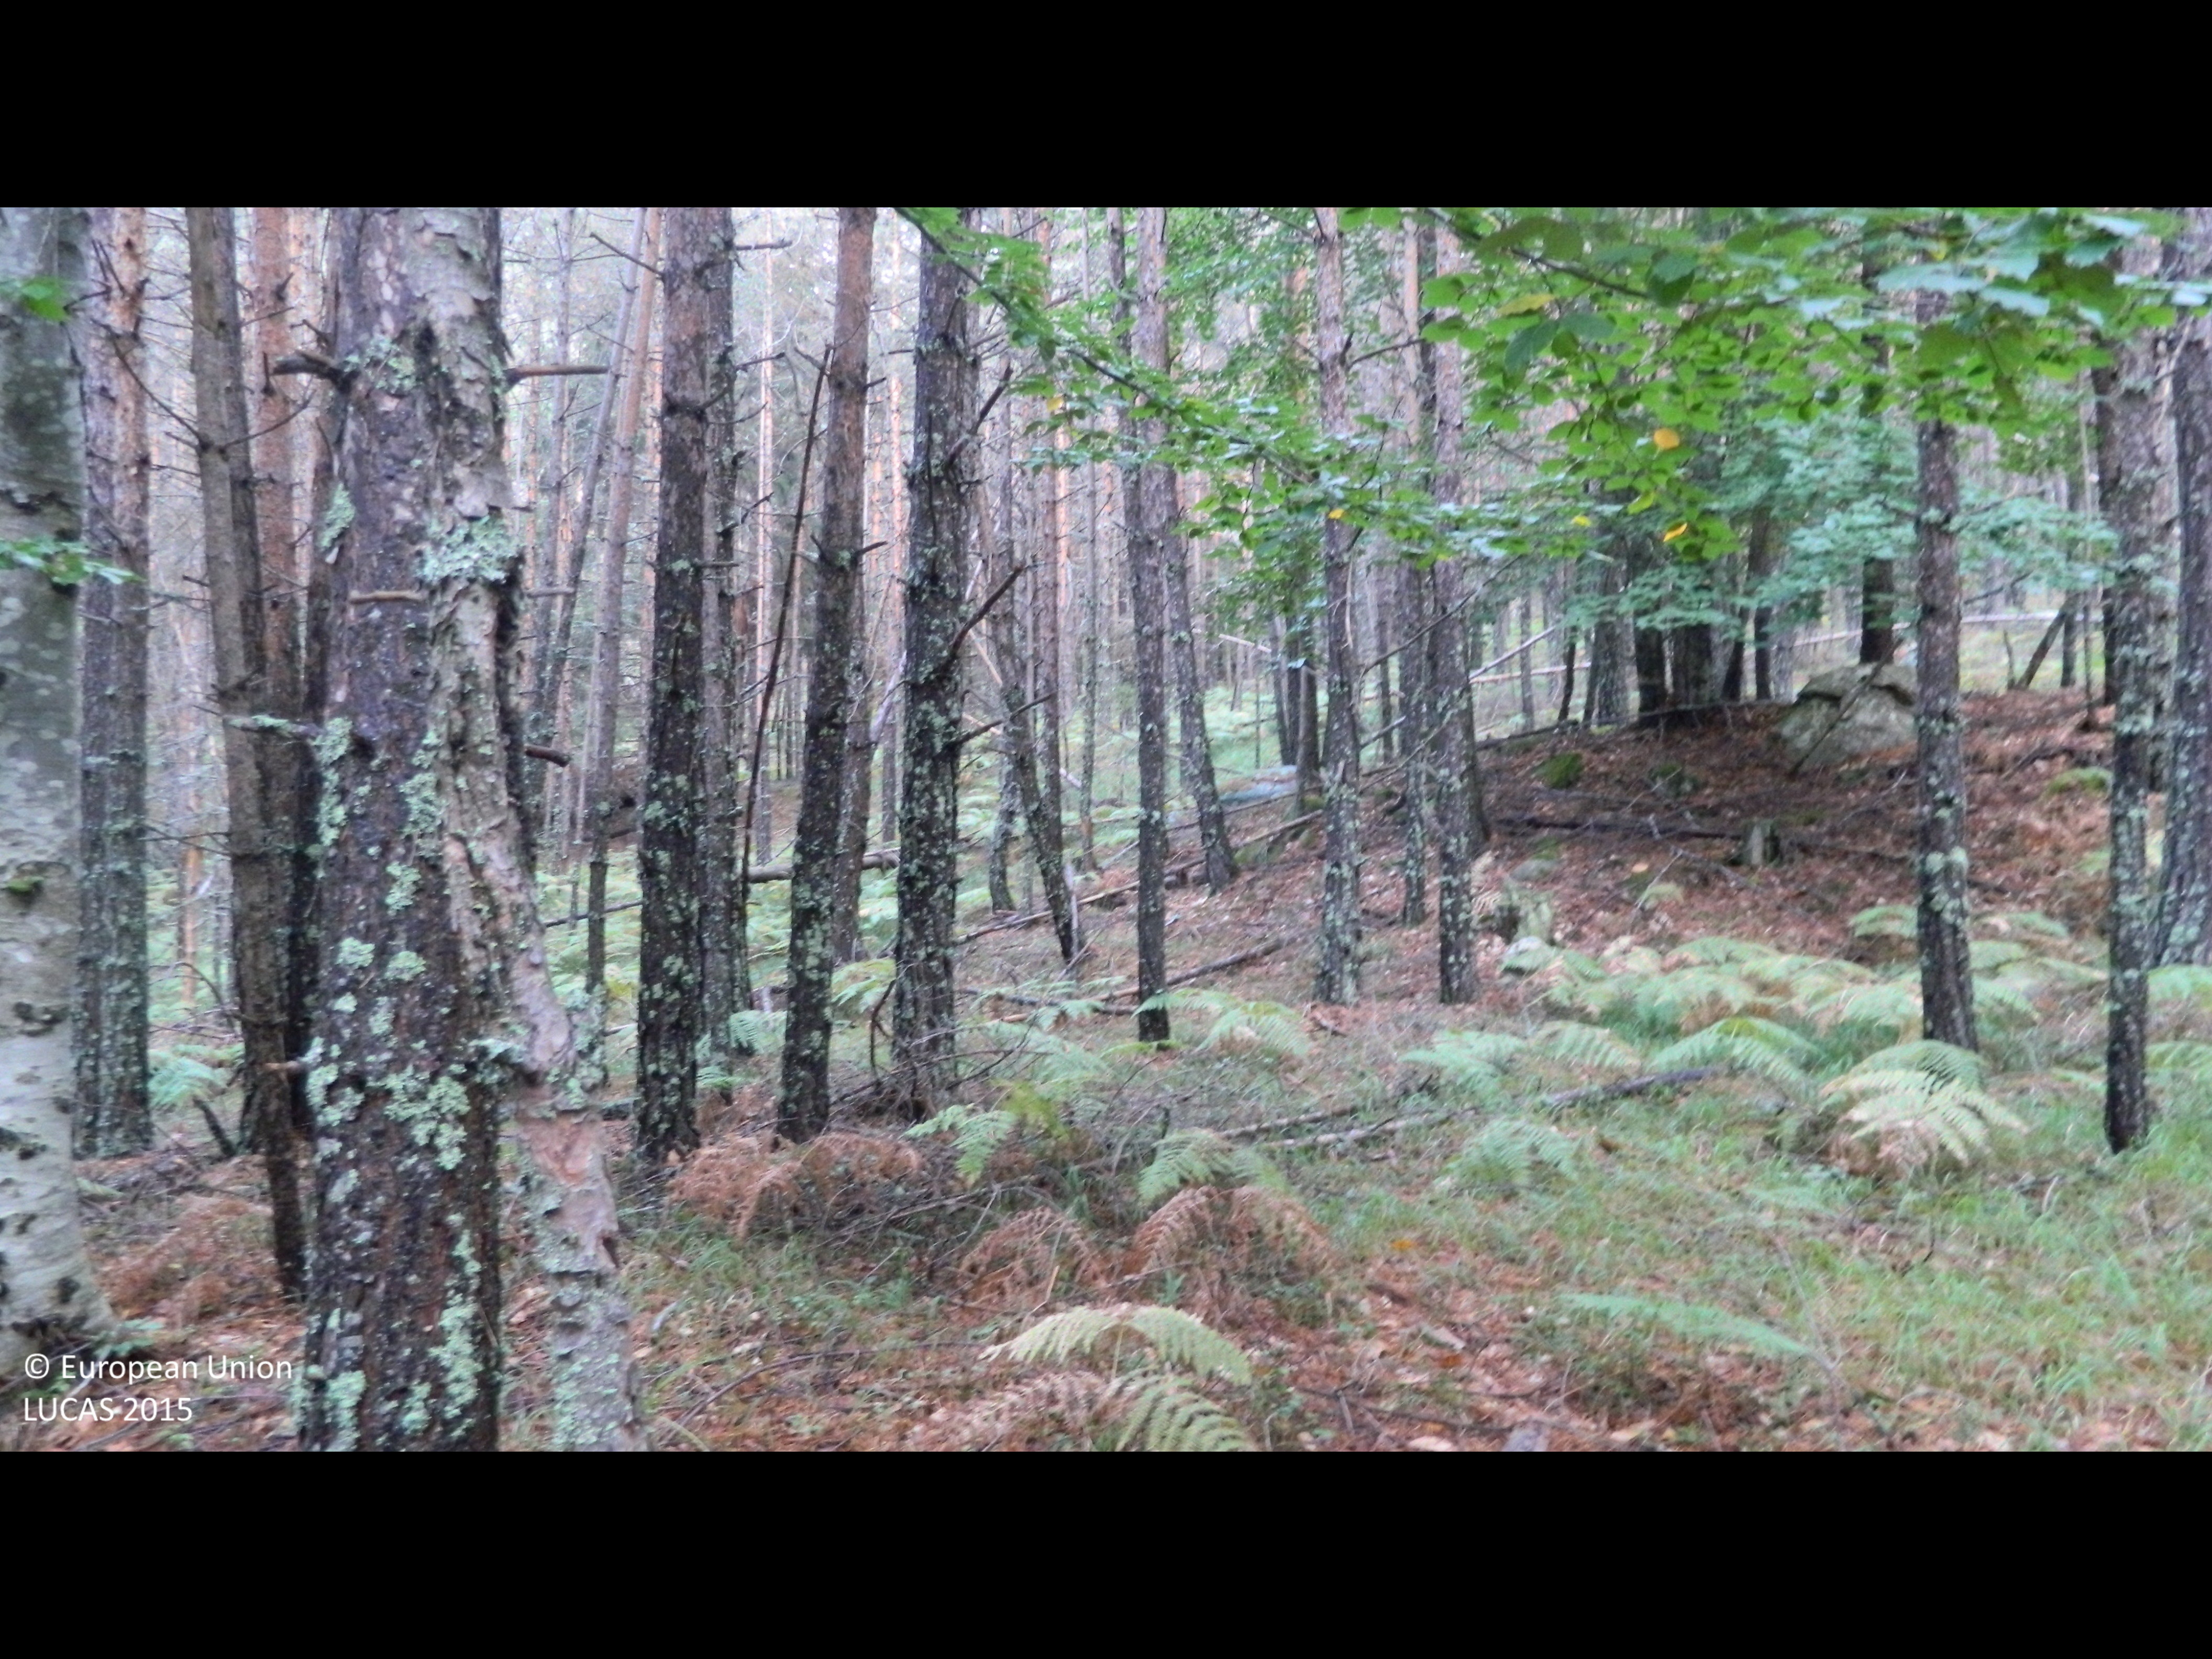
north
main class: Woodland
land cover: Pine dominated coniferous woodland
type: hemiboreal forest and nemoral coniferous forest and mixed broadleaved-coniferous forest
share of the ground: > 75 %
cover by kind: coniferous forest trees 95 %, herbaceous plants 5 %
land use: Forestry
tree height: > 5 m
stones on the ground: < 10 %
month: September
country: BG
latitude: 41.6480
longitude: 24.0702
